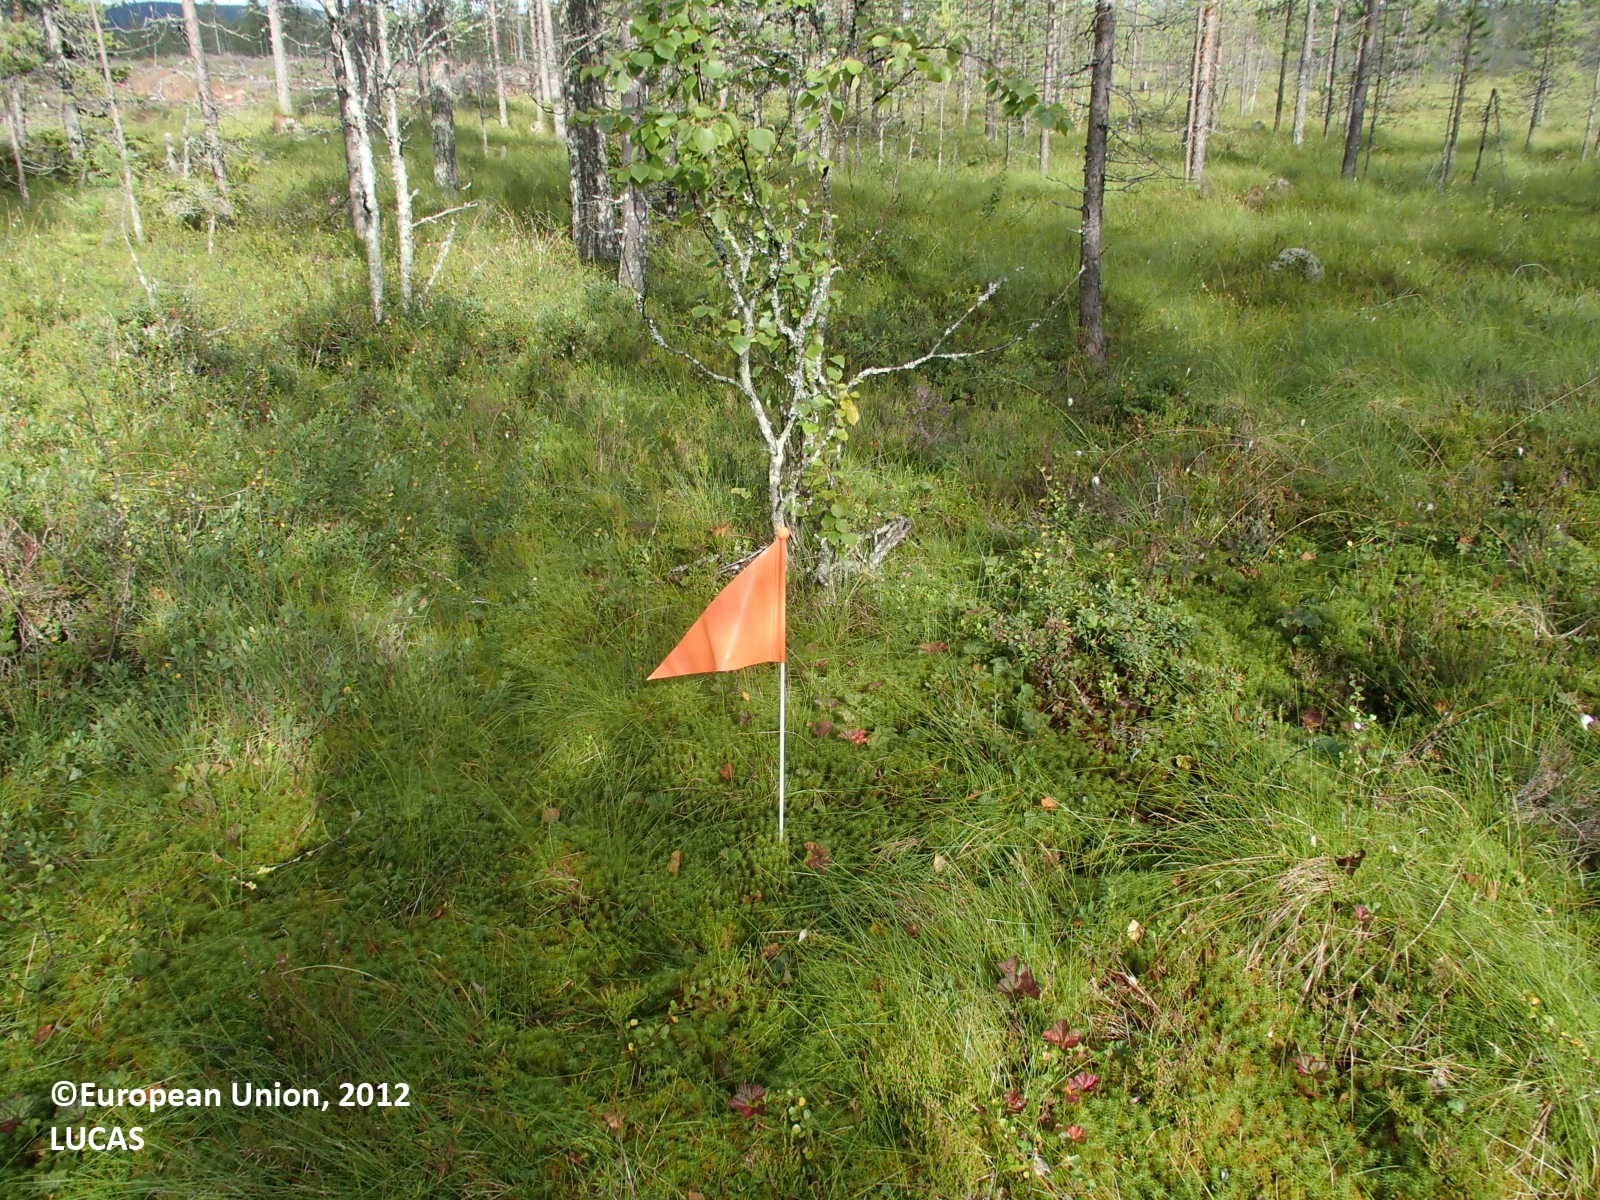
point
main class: Woodland
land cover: Pine dominated mixed woodland
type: boreal forest
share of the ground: 25 - 50 %
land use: Forestry
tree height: > 5 m
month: August
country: FI
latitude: 63.8384
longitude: 28.1641
